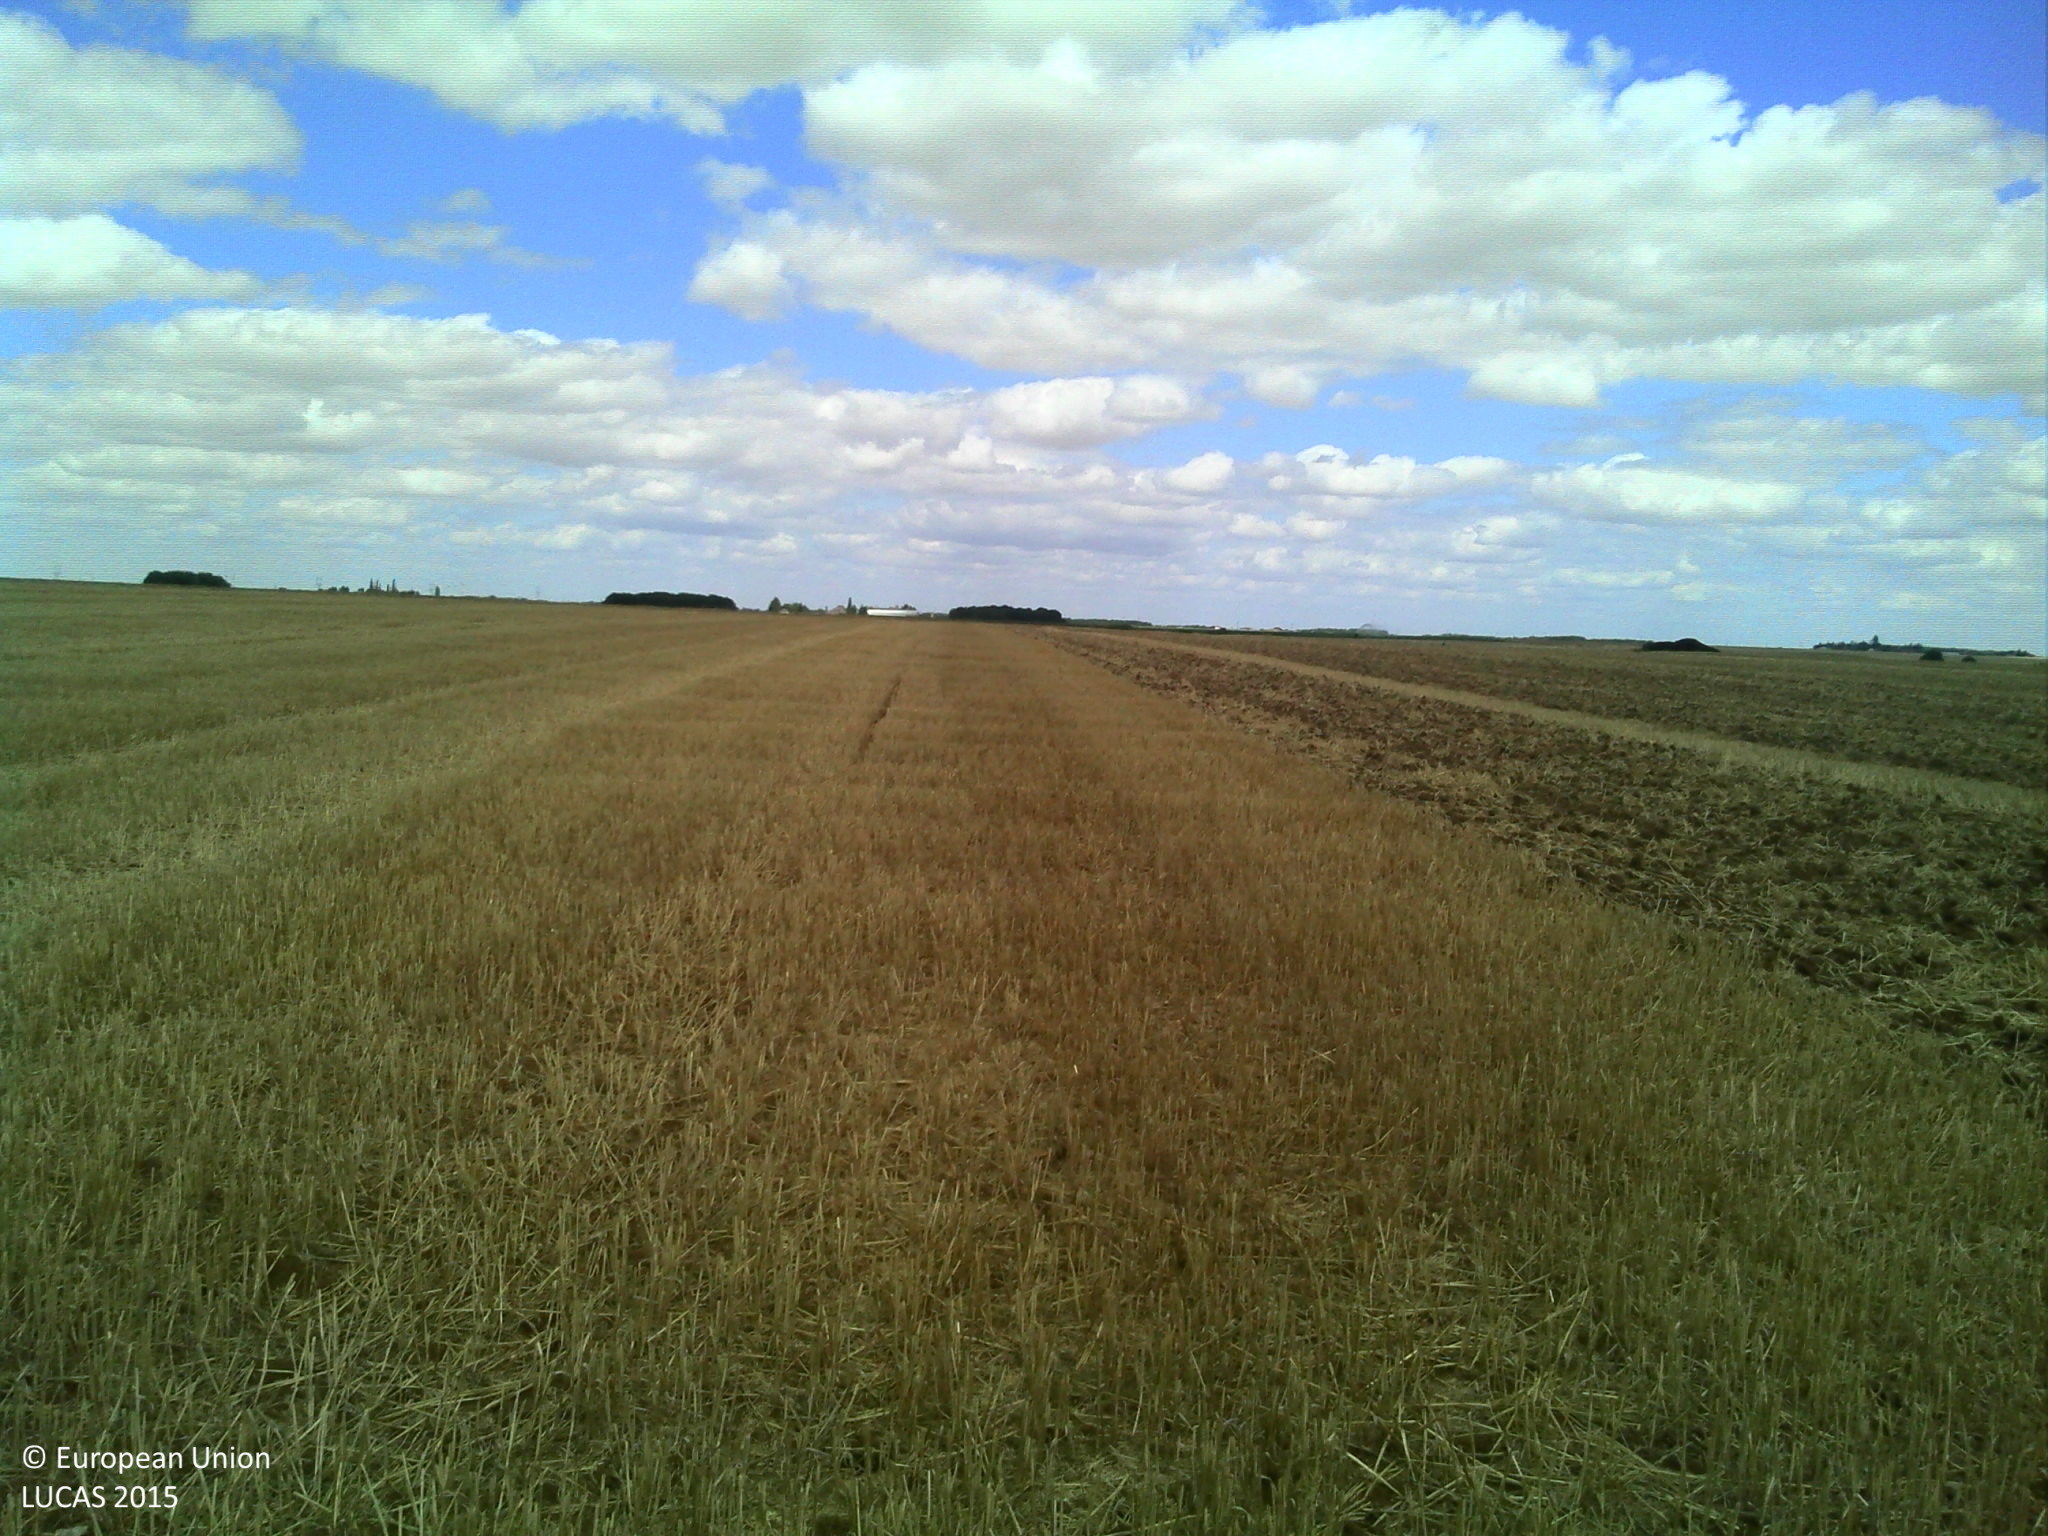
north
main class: Cropland
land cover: Common wheat
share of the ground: > 75 %
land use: Agriculture (excluding fallow land and kitchen gardens)
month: August
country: FR
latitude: 48.2579
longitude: 1.9995
